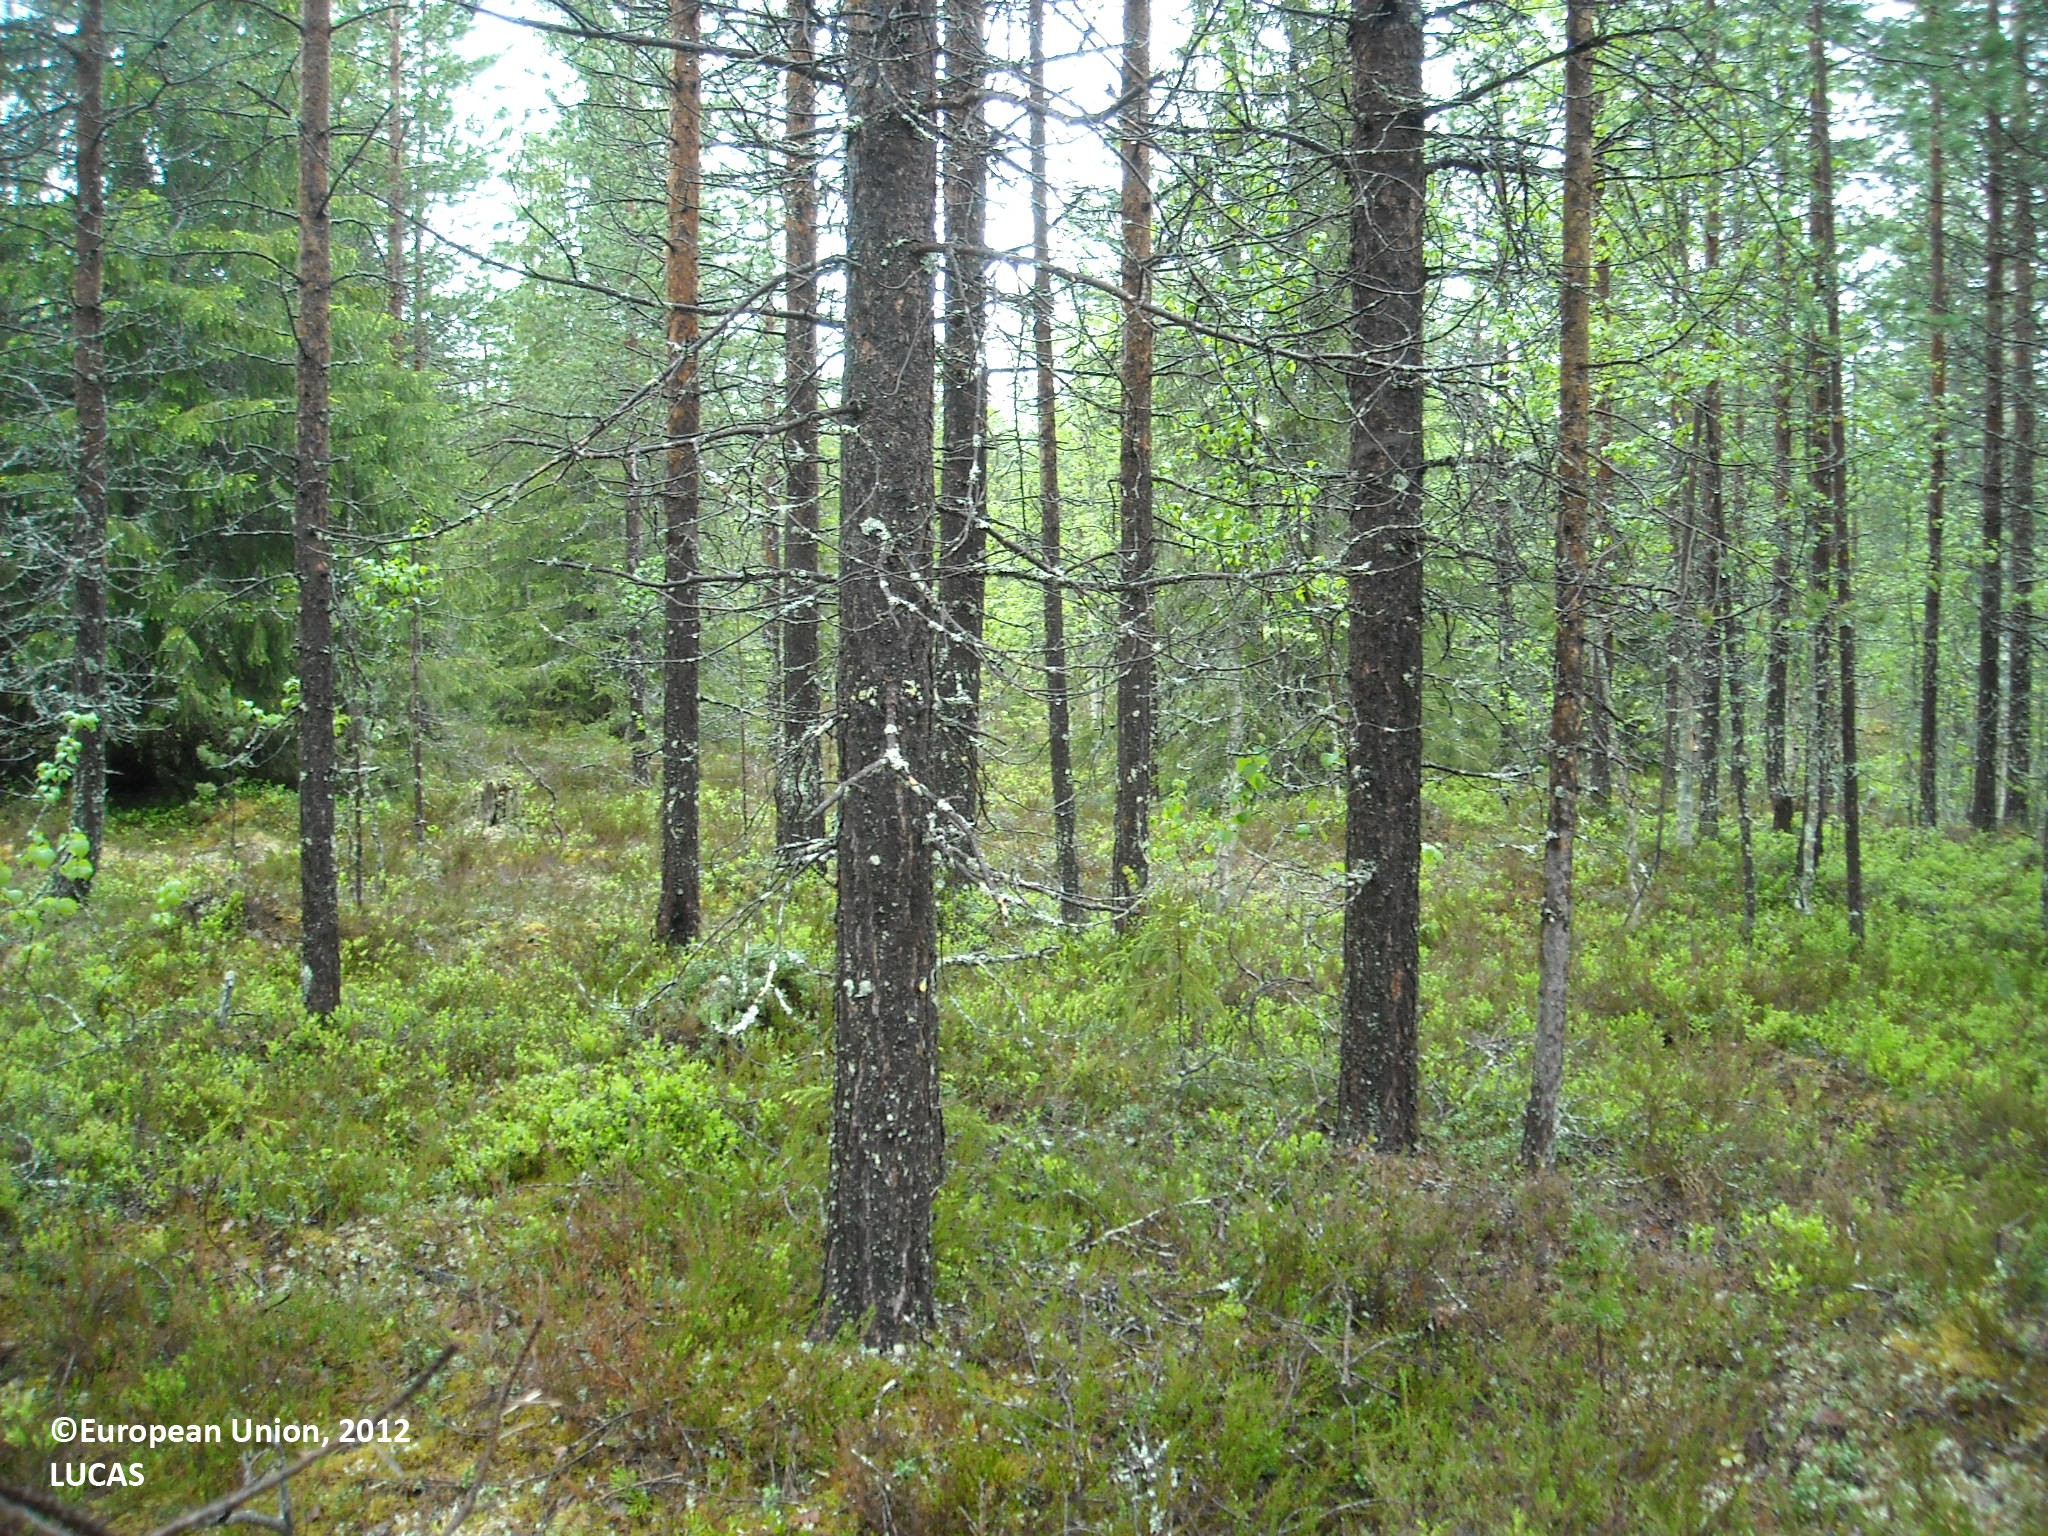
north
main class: Woodland
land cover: Other coniferous woodland
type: boreal forest
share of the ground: > 75 %
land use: Forestry
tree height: > 5 m
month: June
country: FI
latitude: 65.6255
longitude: 27.8808
